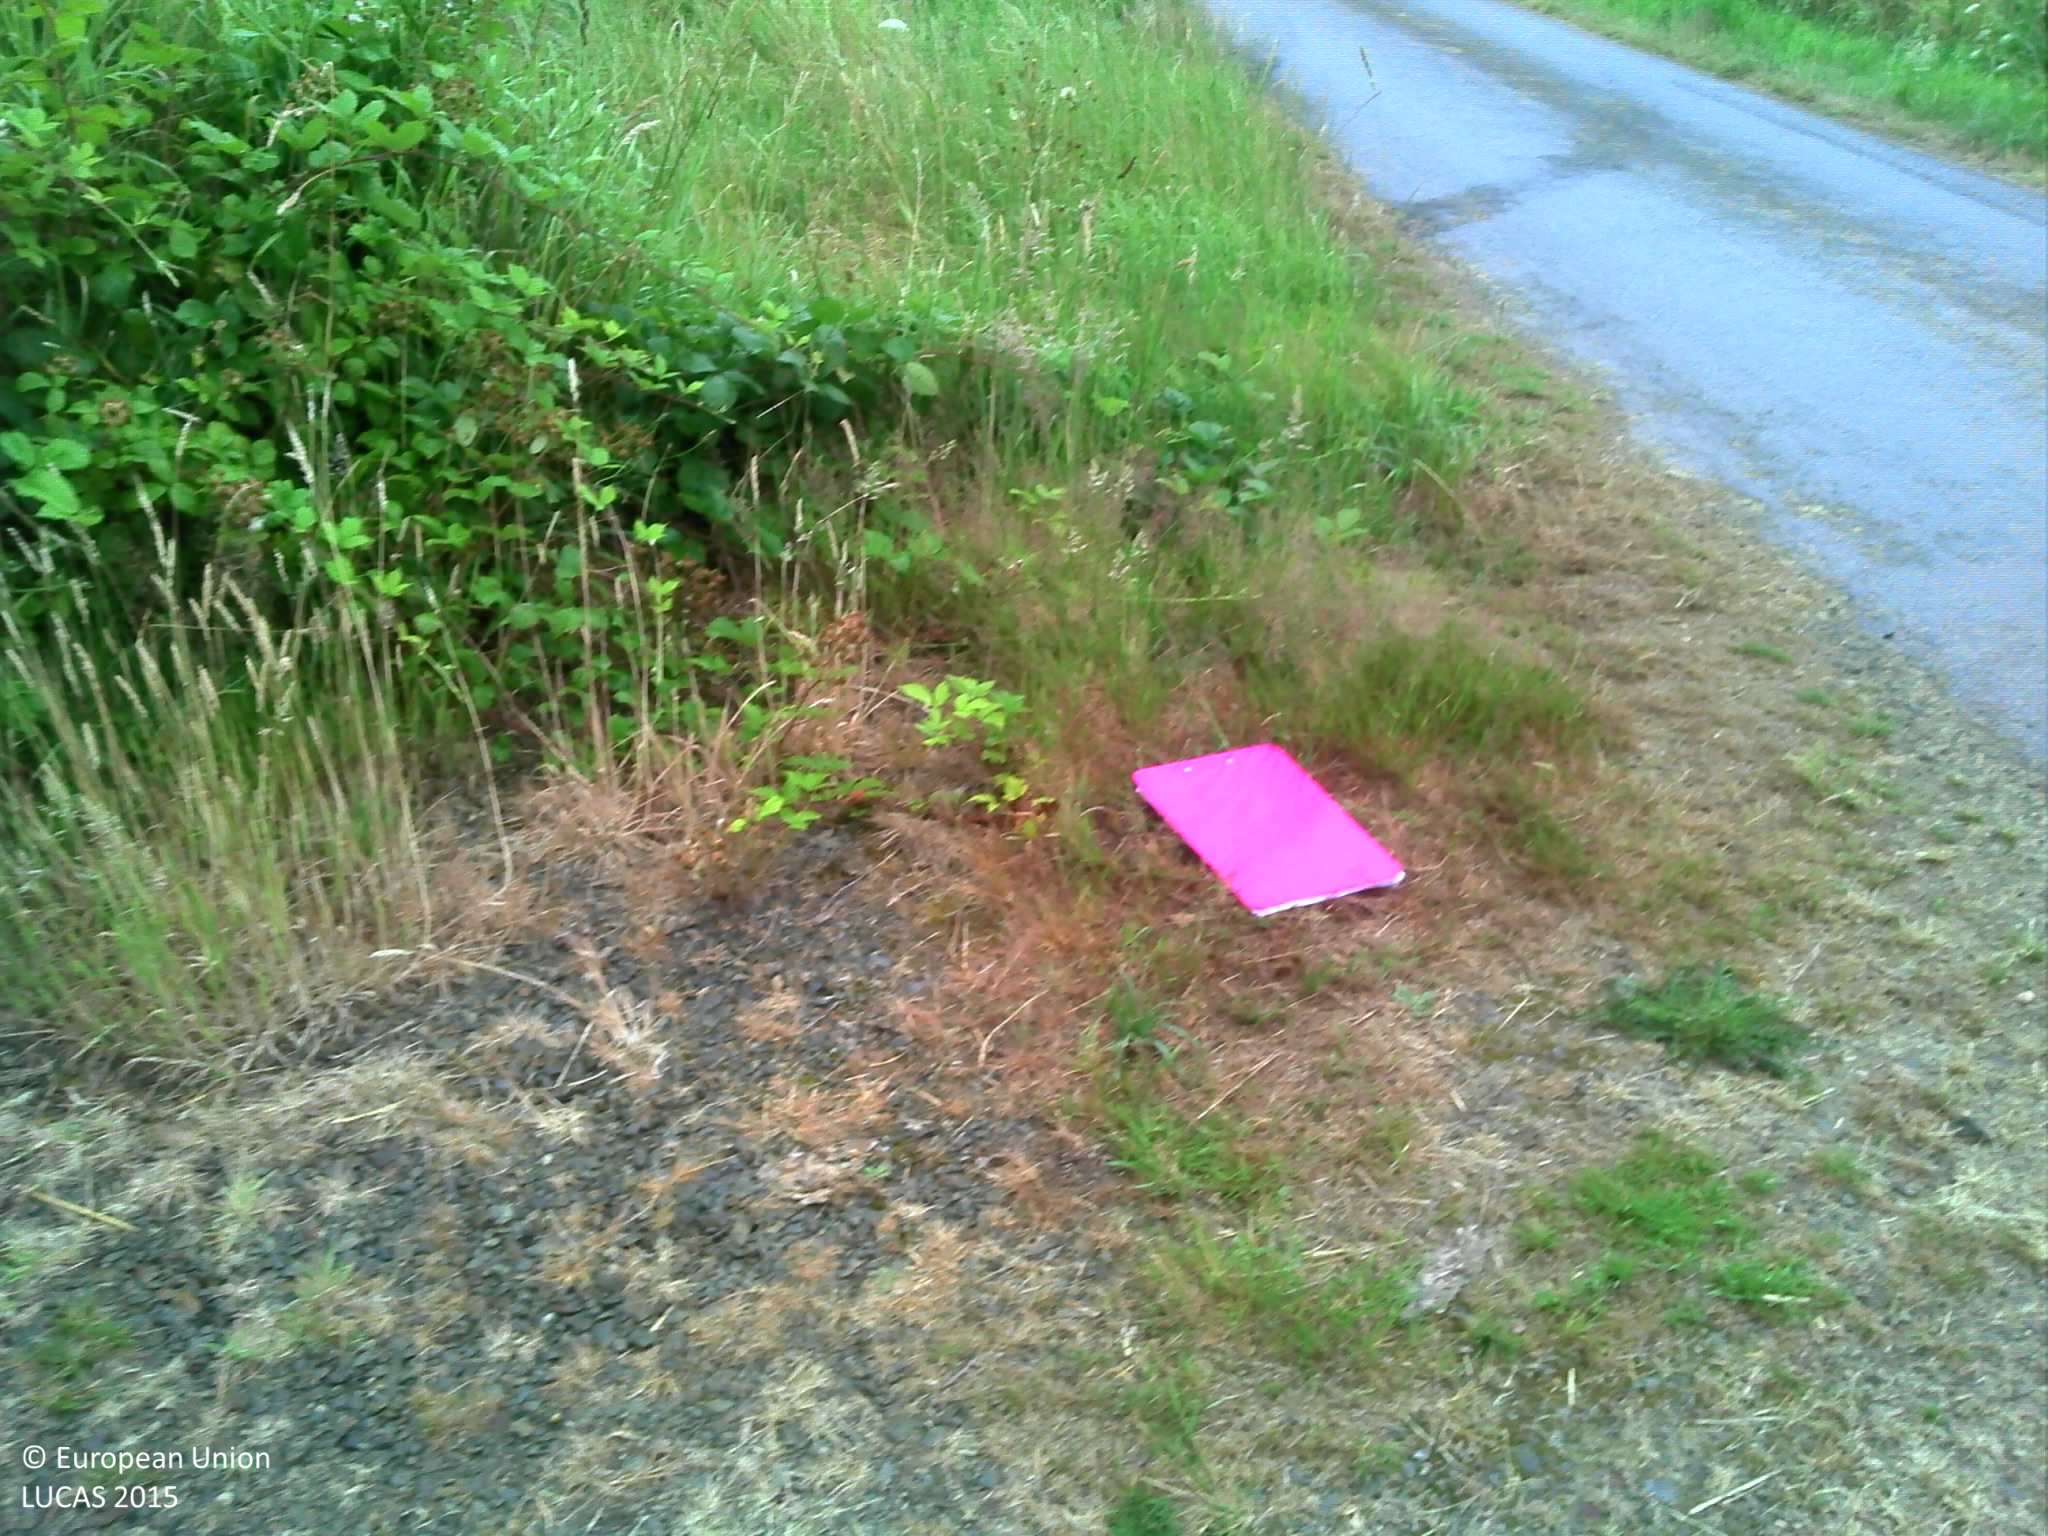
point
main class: Grassland
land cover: Grassland without tree/shrub cover
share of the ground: > 75 %
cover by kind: herbaceous plants 100 %
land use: Agriculture (excluding fallow land and kitchen gardens)
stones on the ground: 10 - 25 %
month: July
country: FR
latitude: 48.2623
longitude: -1.9472
